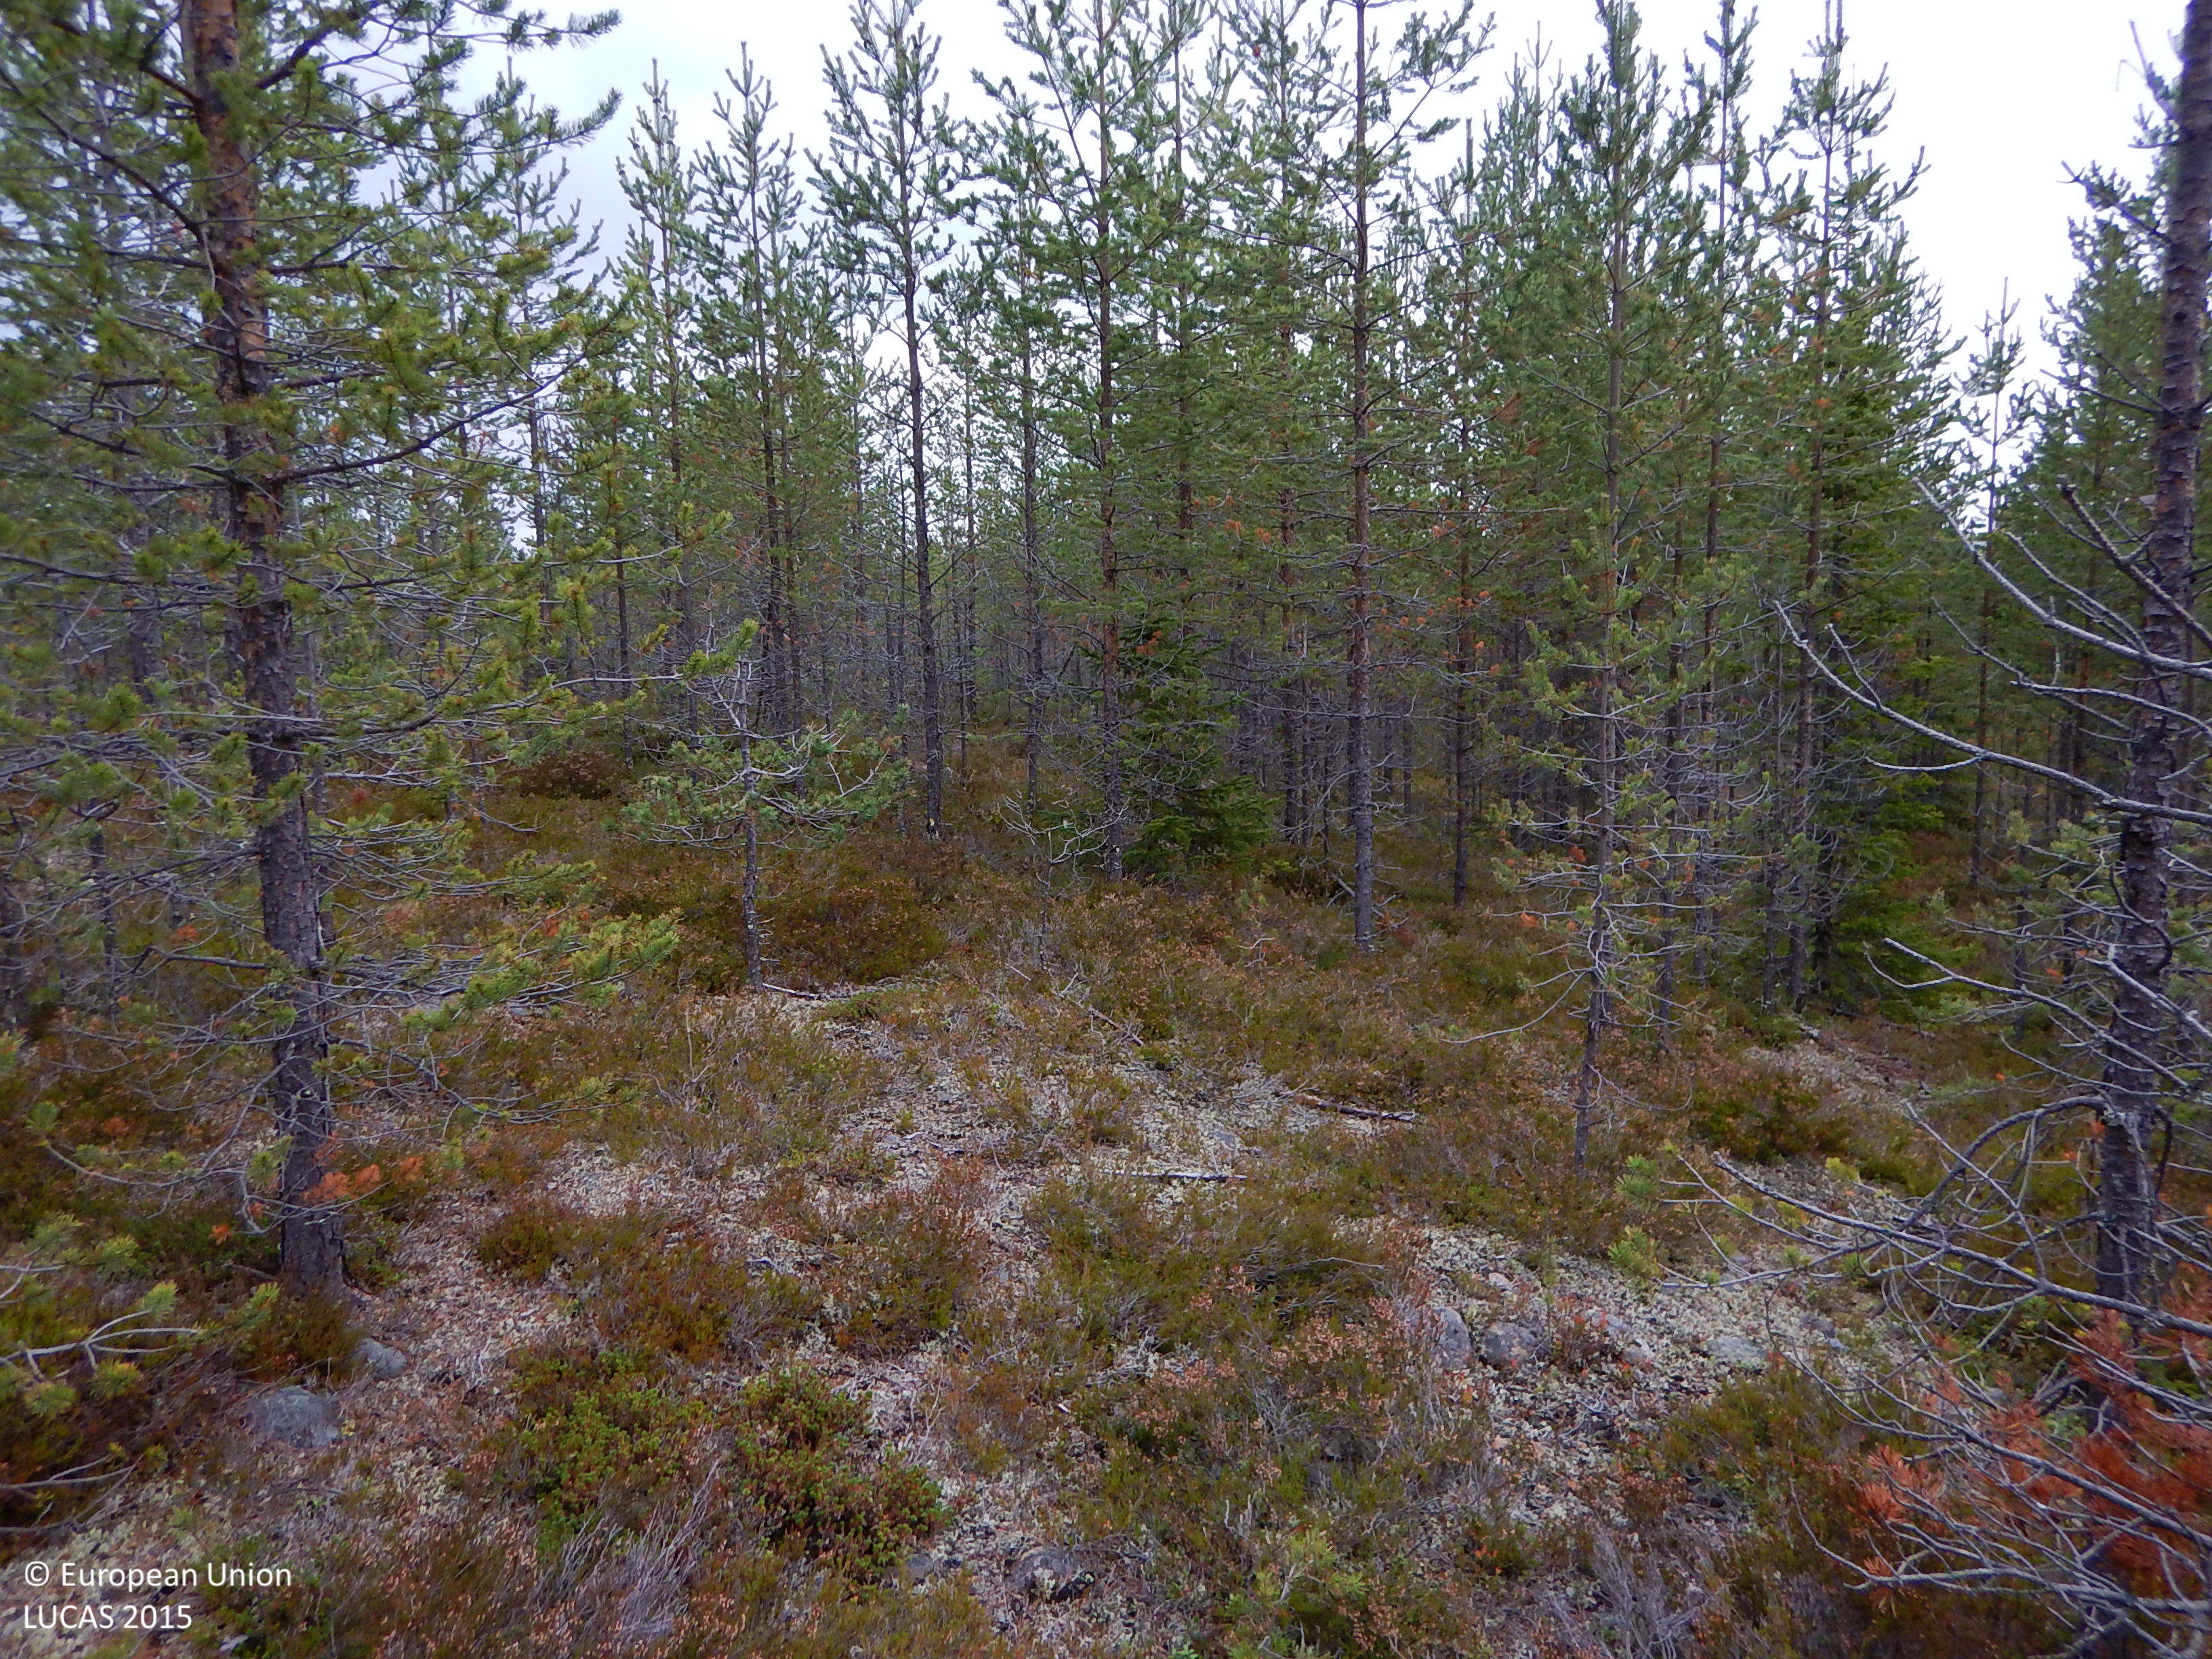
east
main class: Woodland
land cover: Pine dominated coniferous woodland
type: boreal forest
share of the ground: 50 - 75 %
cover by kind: coniferous forest trees 60 %, shrubs 15 %, lichens and mosses 15 %, herbaceous plants 5 %, unconsolidated bare surface 5 %
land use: Forestry
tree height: > 5 m
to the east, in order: Pine dominated coniferous woodland; Tracks; Pine dominated coniferous woodland
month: September
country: SE
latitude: 65.0790
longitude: 19.1749
